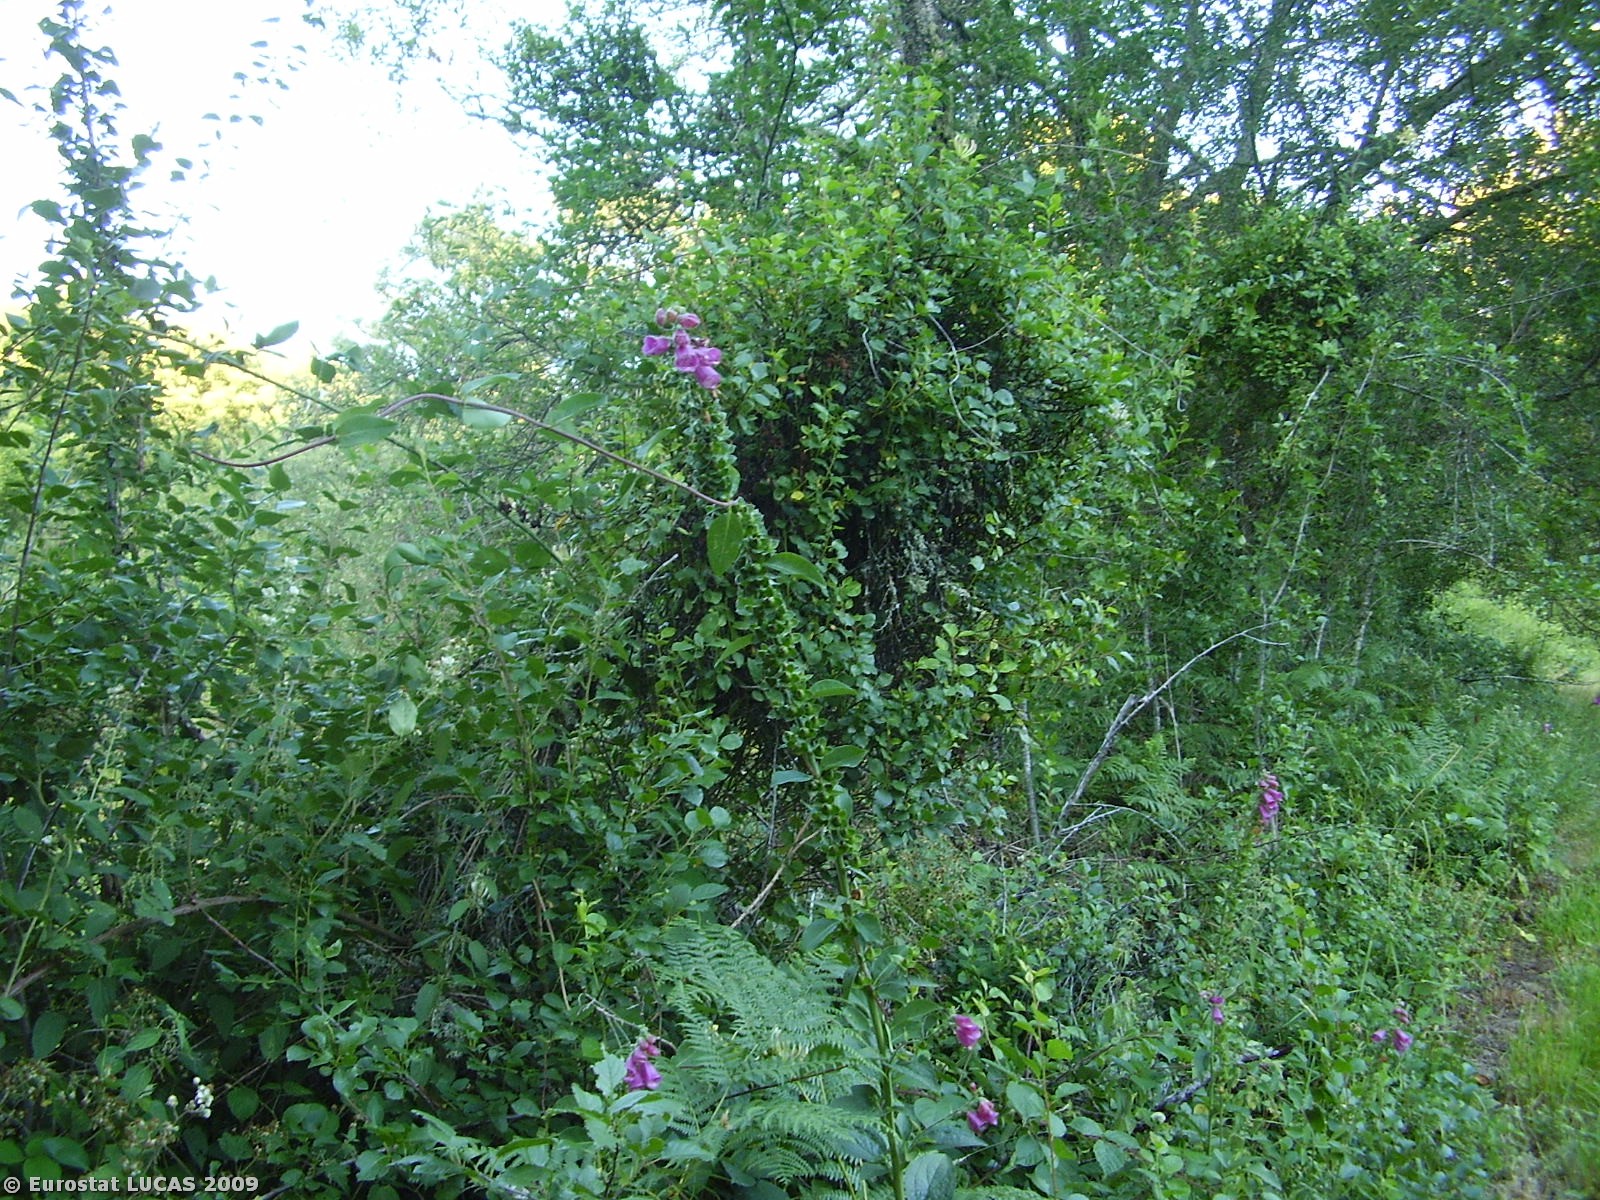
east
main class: Grassland
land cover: Grassland without tree/shrub cover
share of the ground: > 75 %
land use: Agriculture (excluding fallow land and kitchen gardens)
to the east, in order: Grassland without tree/shrub cover; Shruby margins; Abandoned hedges; Dry stone walls; Grassland without tree/shrub cover; Abandoned hedges; Dry stone walls; Abandoned hedges; Shrubland with sparse tree cover; Ditches and canals; Shrubland with sparse tree cover
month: July
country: PT
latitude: 41.5327
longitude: -7.5438
